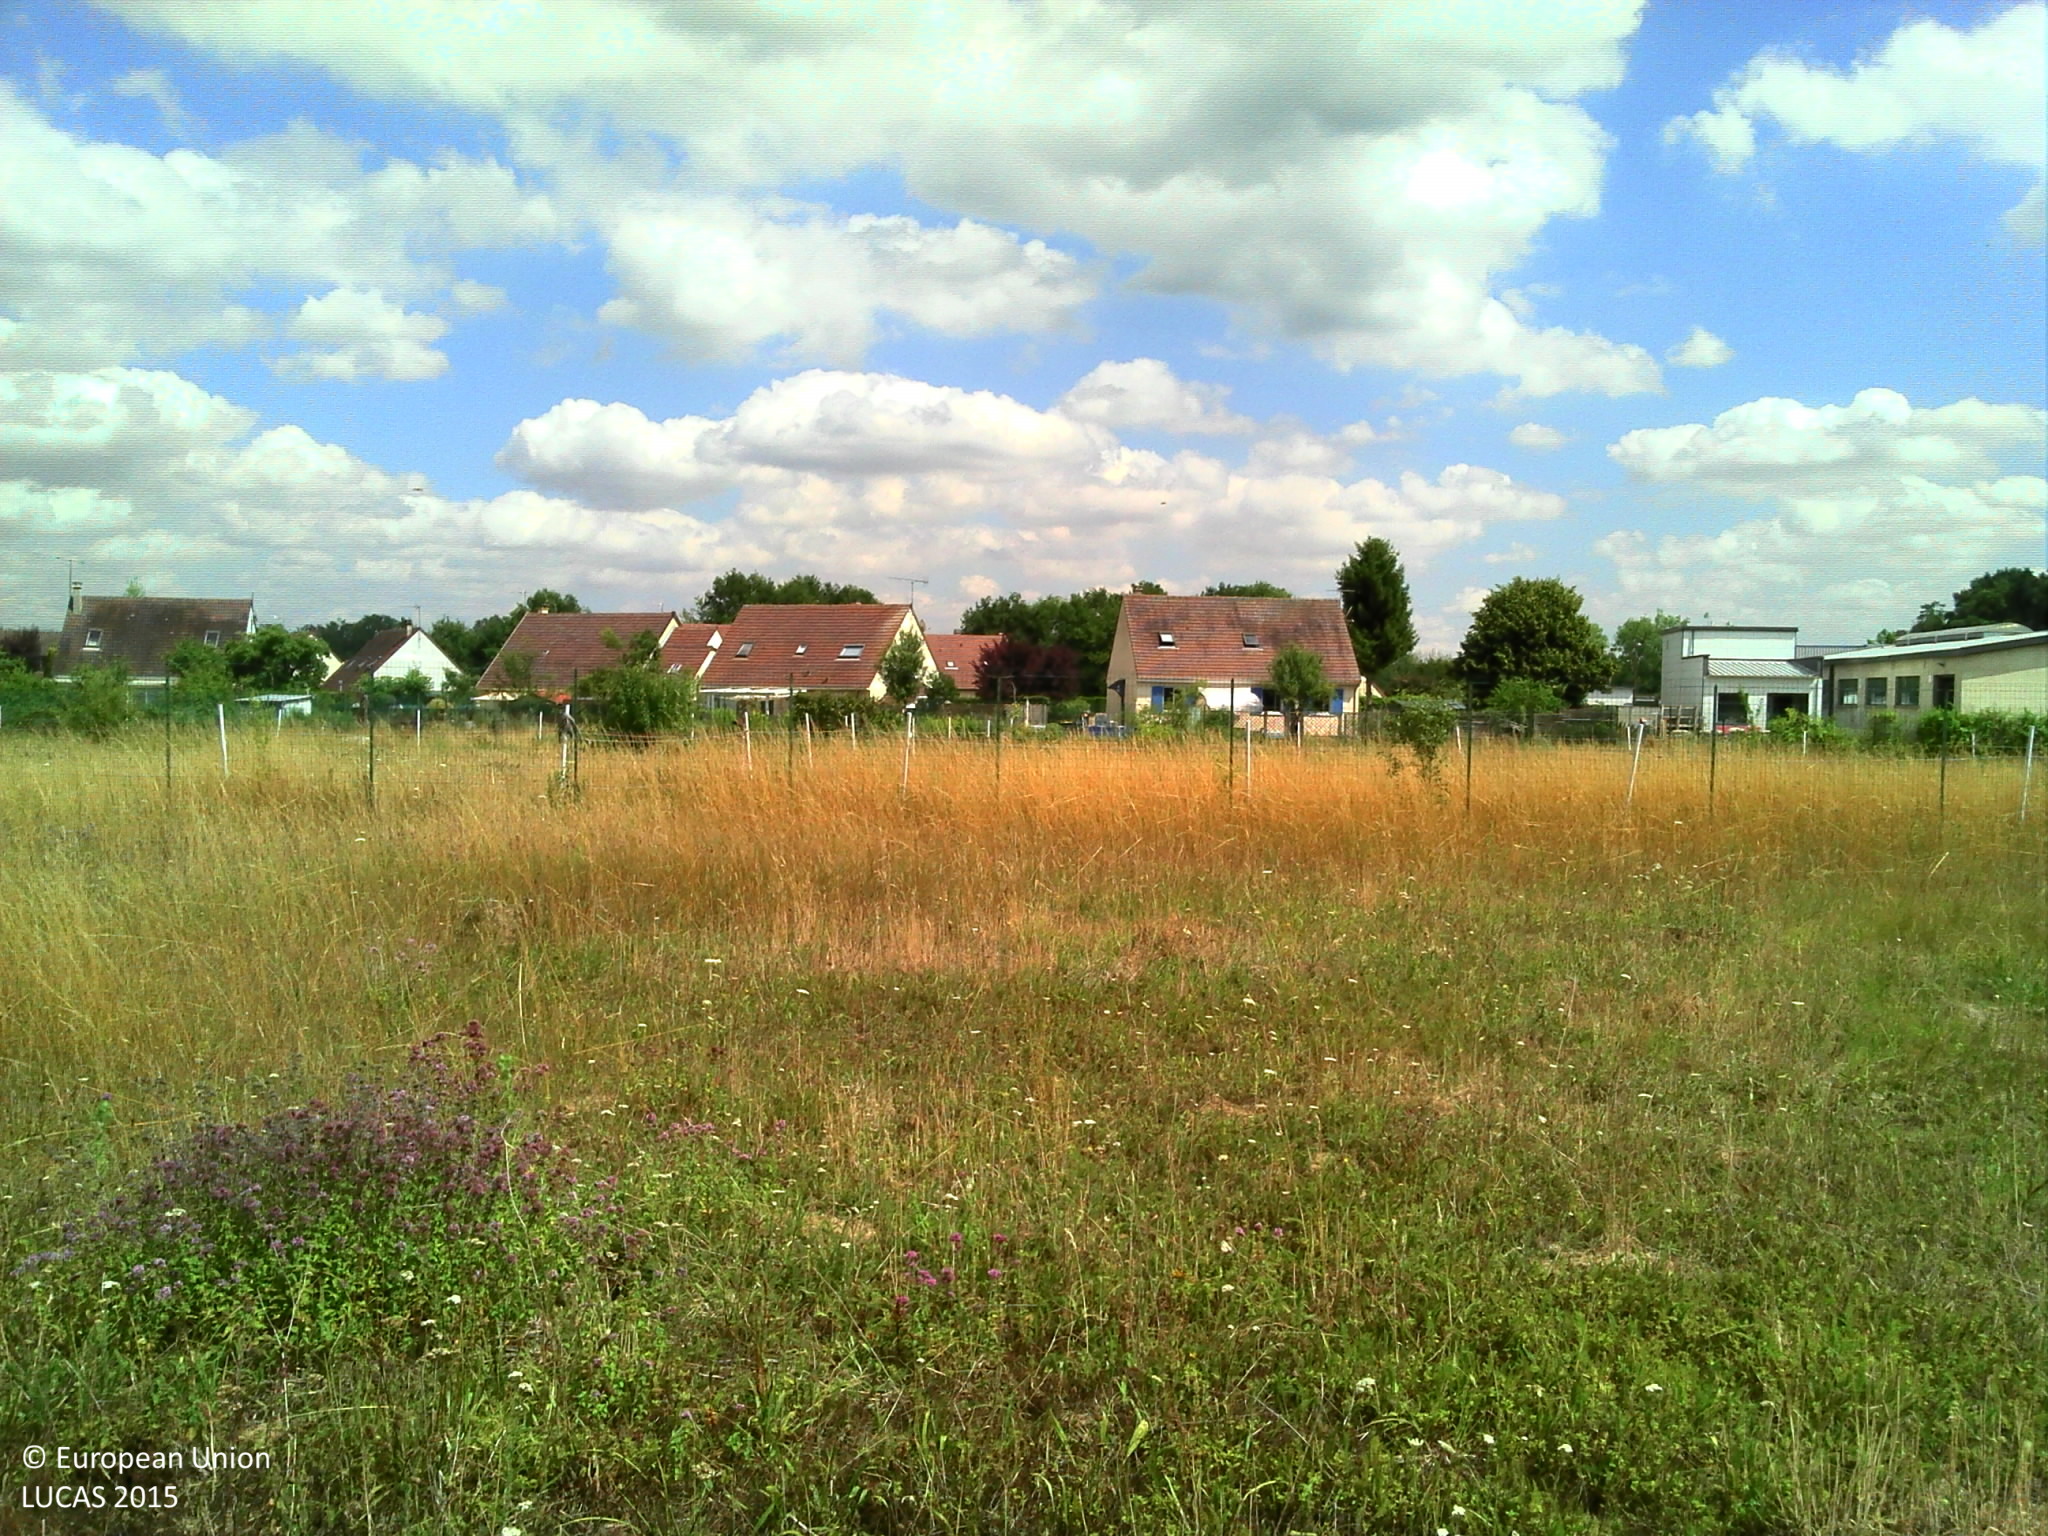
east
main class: Grassland
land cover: Grassland without tree/shrub cover
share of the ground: > 75 %
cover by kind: herbaceous plants 100 %
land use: Agriculture (excluding fallow land and kitchen gardens)
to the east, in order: Grassland without tree/shrub cover; Fences; Grass margins; Fences; Grassland without tree/shrub cover; Fences; Grassland without tree/shrub cover; Artificial constructions in urban areas; Electric lines; Paved roads, cycling and walking lanes; Electric lines; Grass margins; Grassland without tree/shrub cover; Broadleaved woodland; Electric lines; Tracks; Grass margins; Temporary grasslands
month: July
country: FR
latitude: 49.1471
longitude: 2.5720
